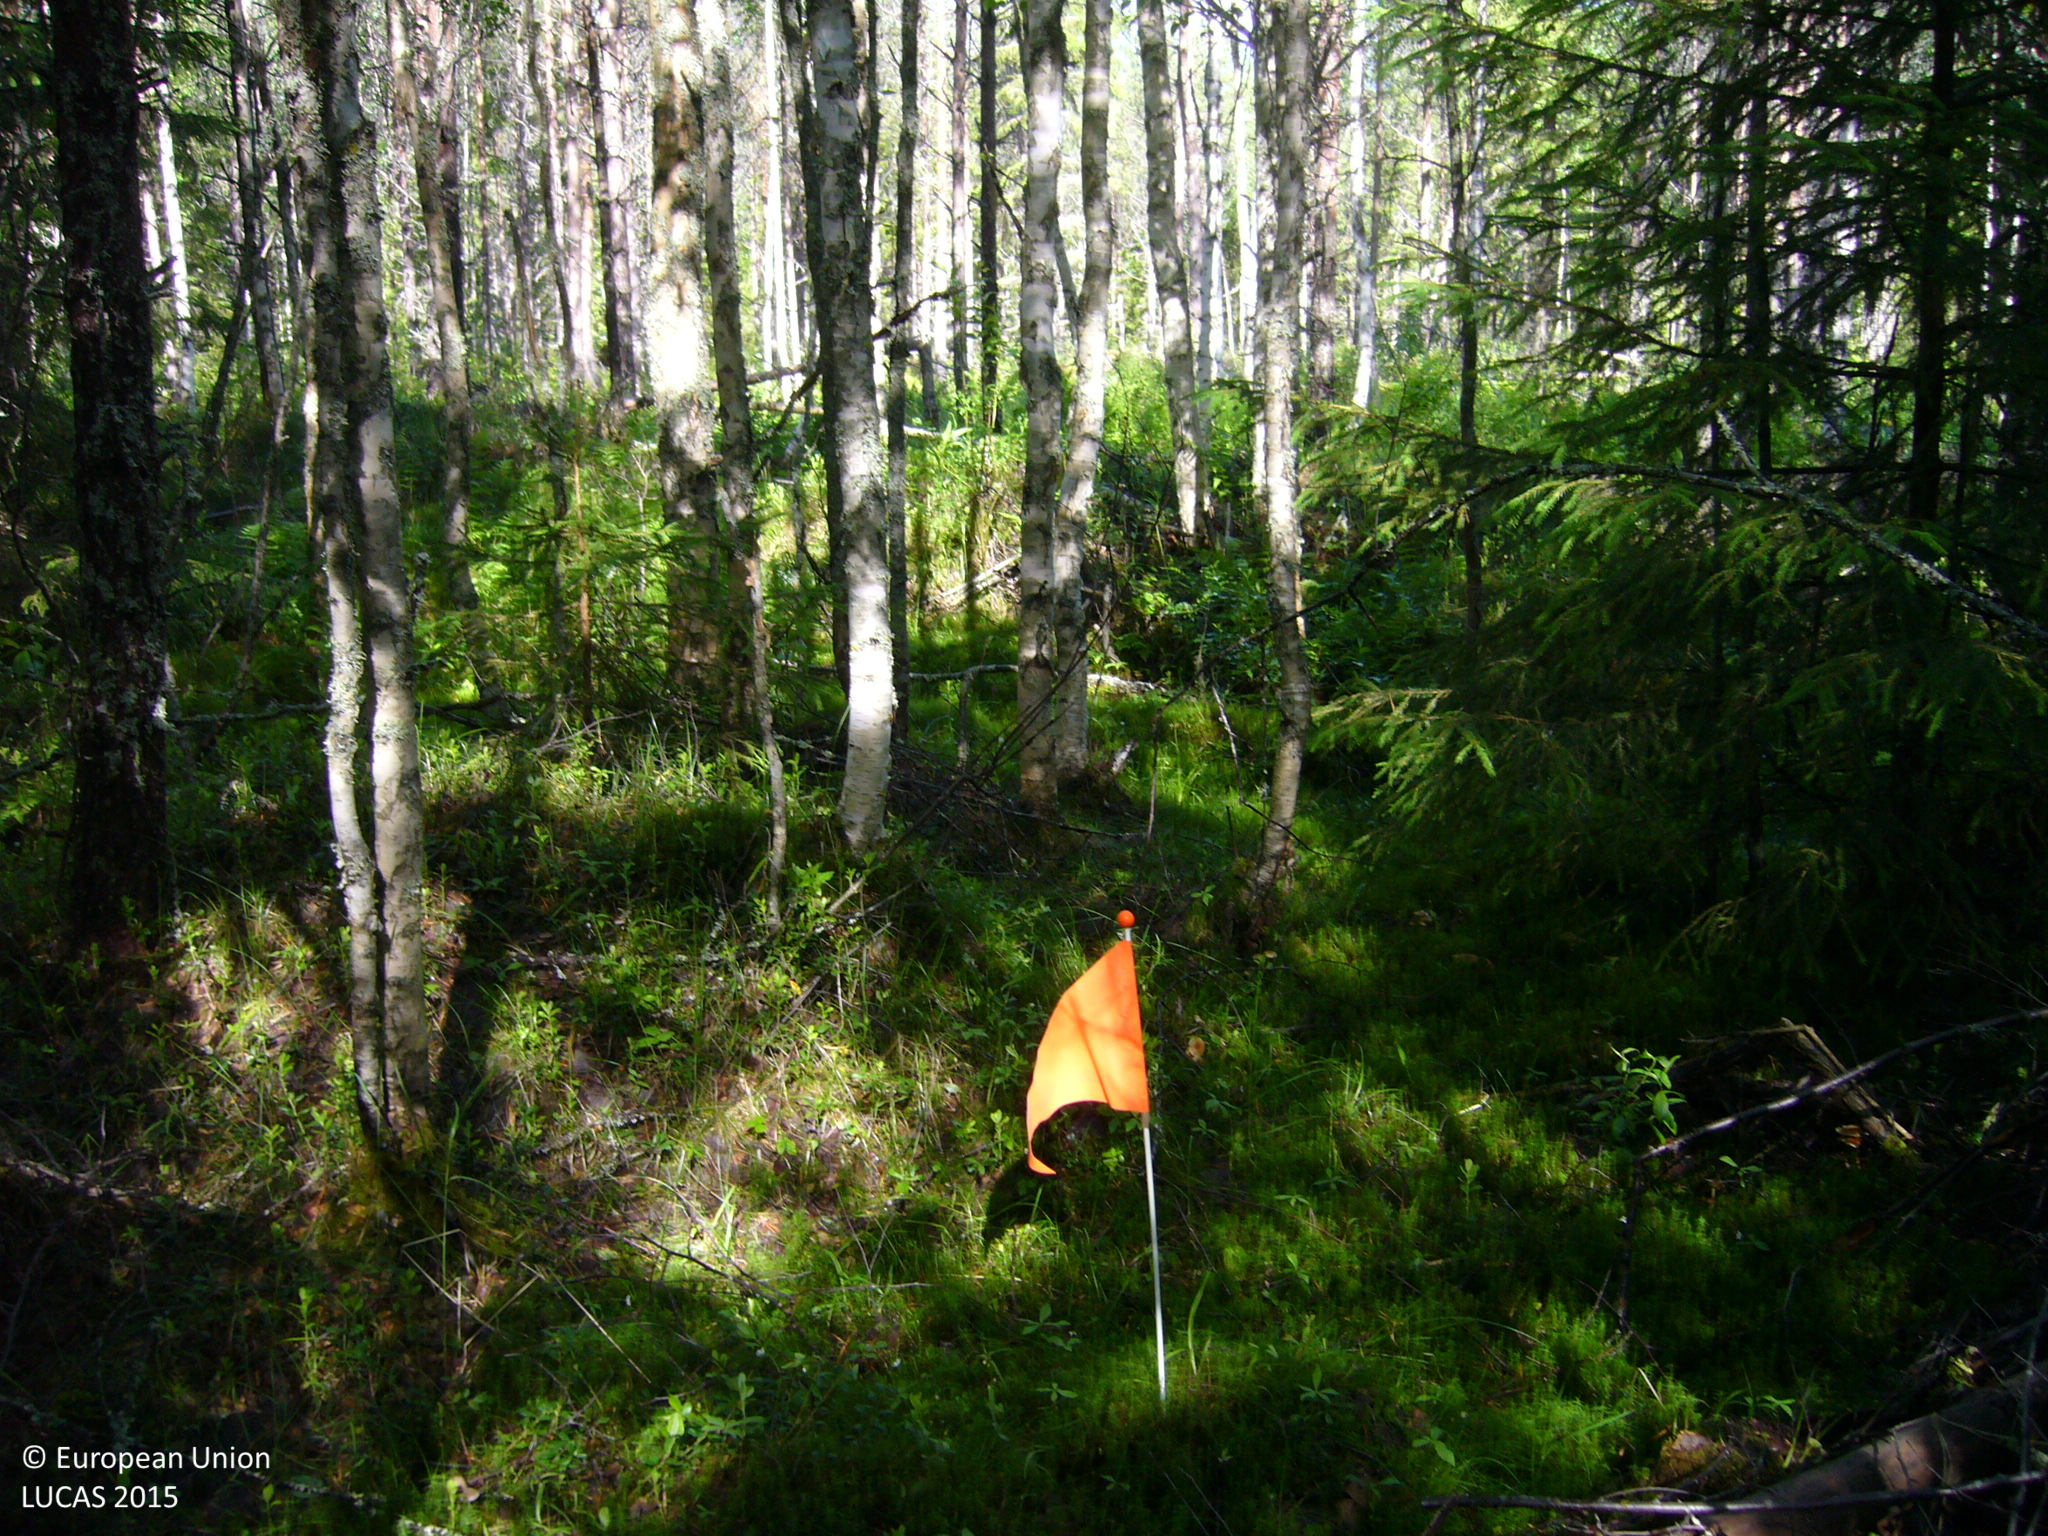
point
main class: Woodland
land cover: Other mixed woodland
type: boreal forest
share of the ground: > 75 %
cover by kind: broadleaved forest trees 50 %, coniferous forest trees 40 %, shrubs 10 %
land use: Forestry
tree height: > 5 m
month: July
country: FI
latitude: 63.6054
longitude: 26.2691
